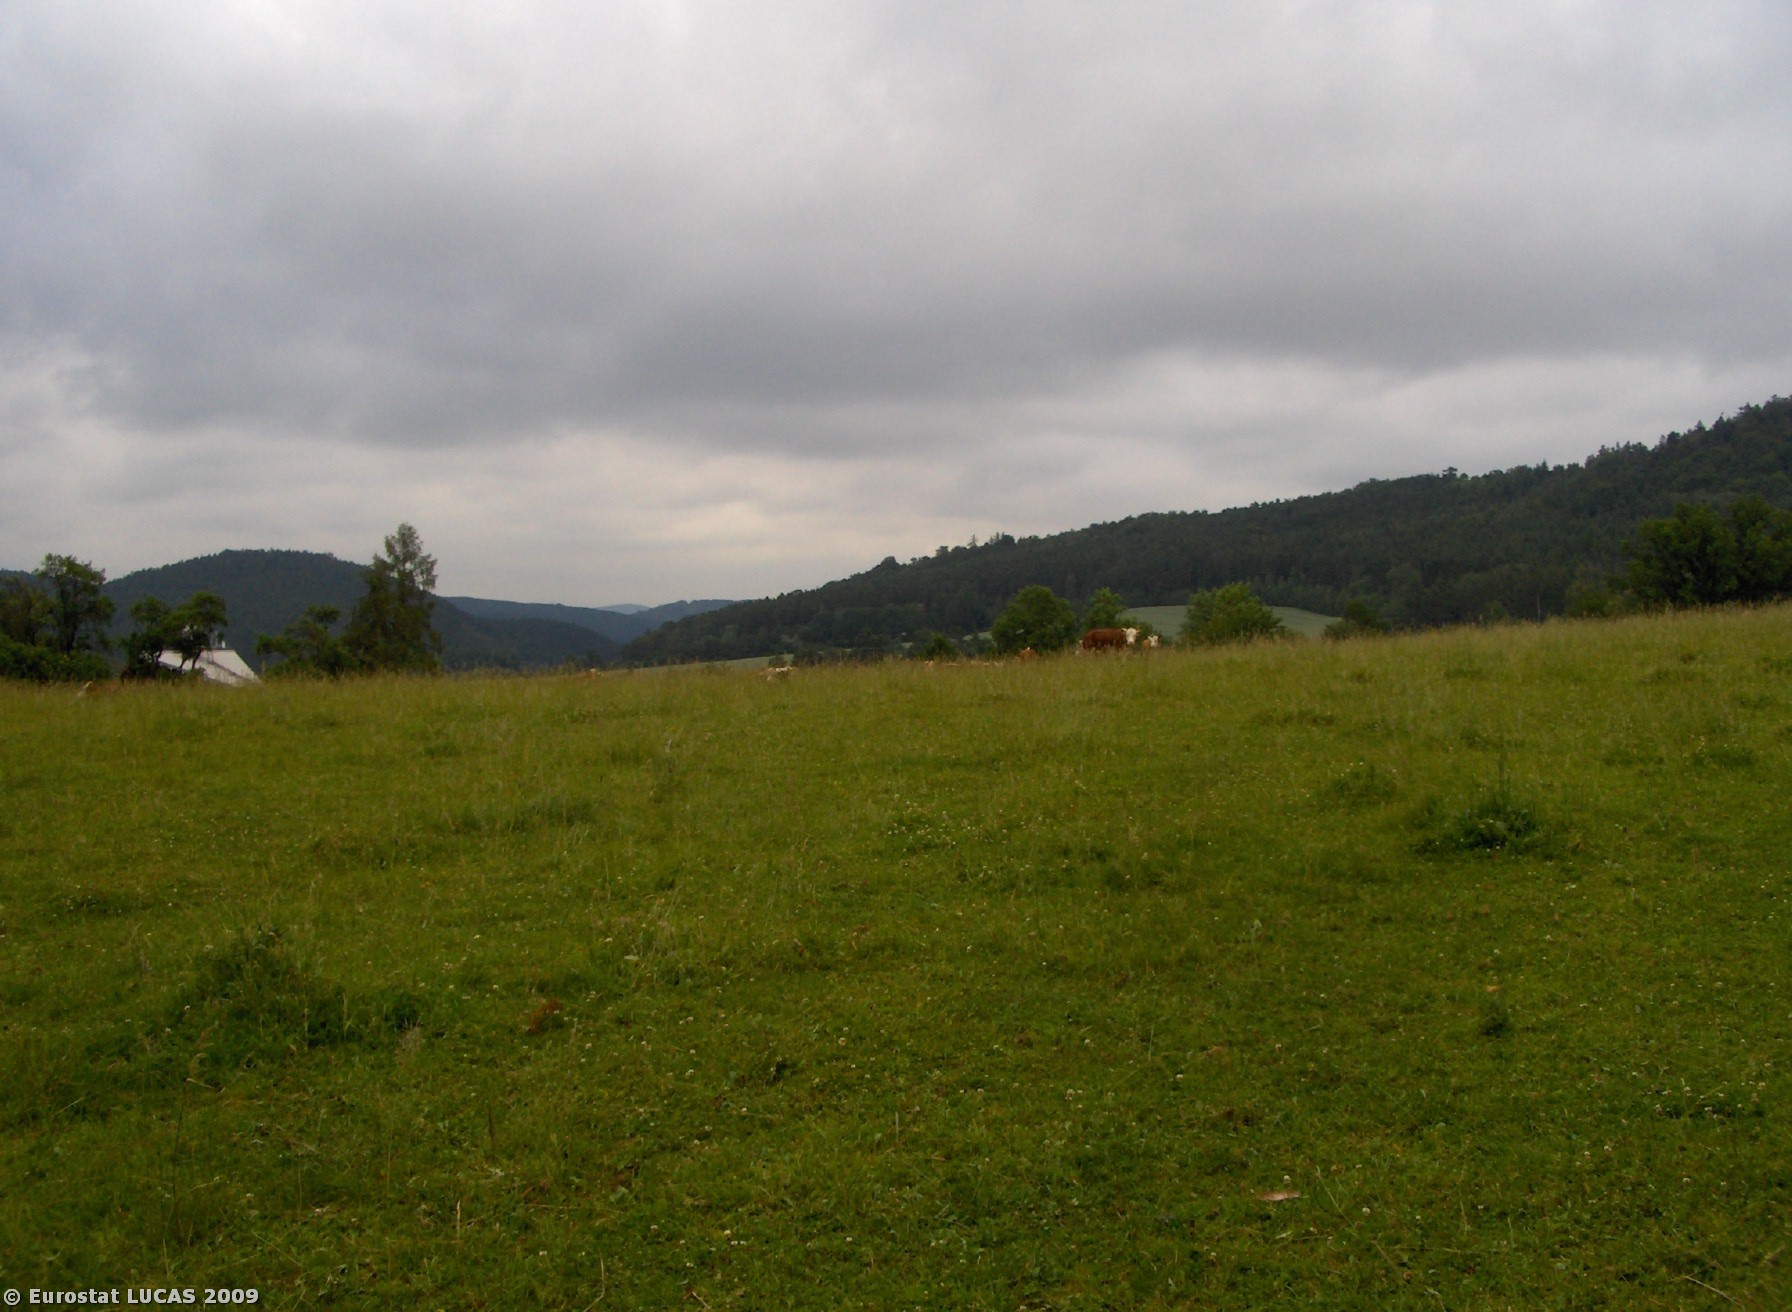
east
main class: Woodland
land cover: Mixed woodland
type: hemiboreal forest and nemoral coniferous forest and mixed broadleaved-coniferous forest
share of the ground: > 75 %
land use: Forestry
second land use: Agriculture (excluding fallow land and kitchen gardens)
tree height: > 5 m
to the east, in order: Mixed woodland; Grassland without tree/shrub cover; Fences; Grassland without tree/shrub cover; Fences; Broadleaved woodland; Tracks; Broadleaved woodland; Common wheat
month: June
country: CZ
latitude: 49.7761
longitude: 14.3756
